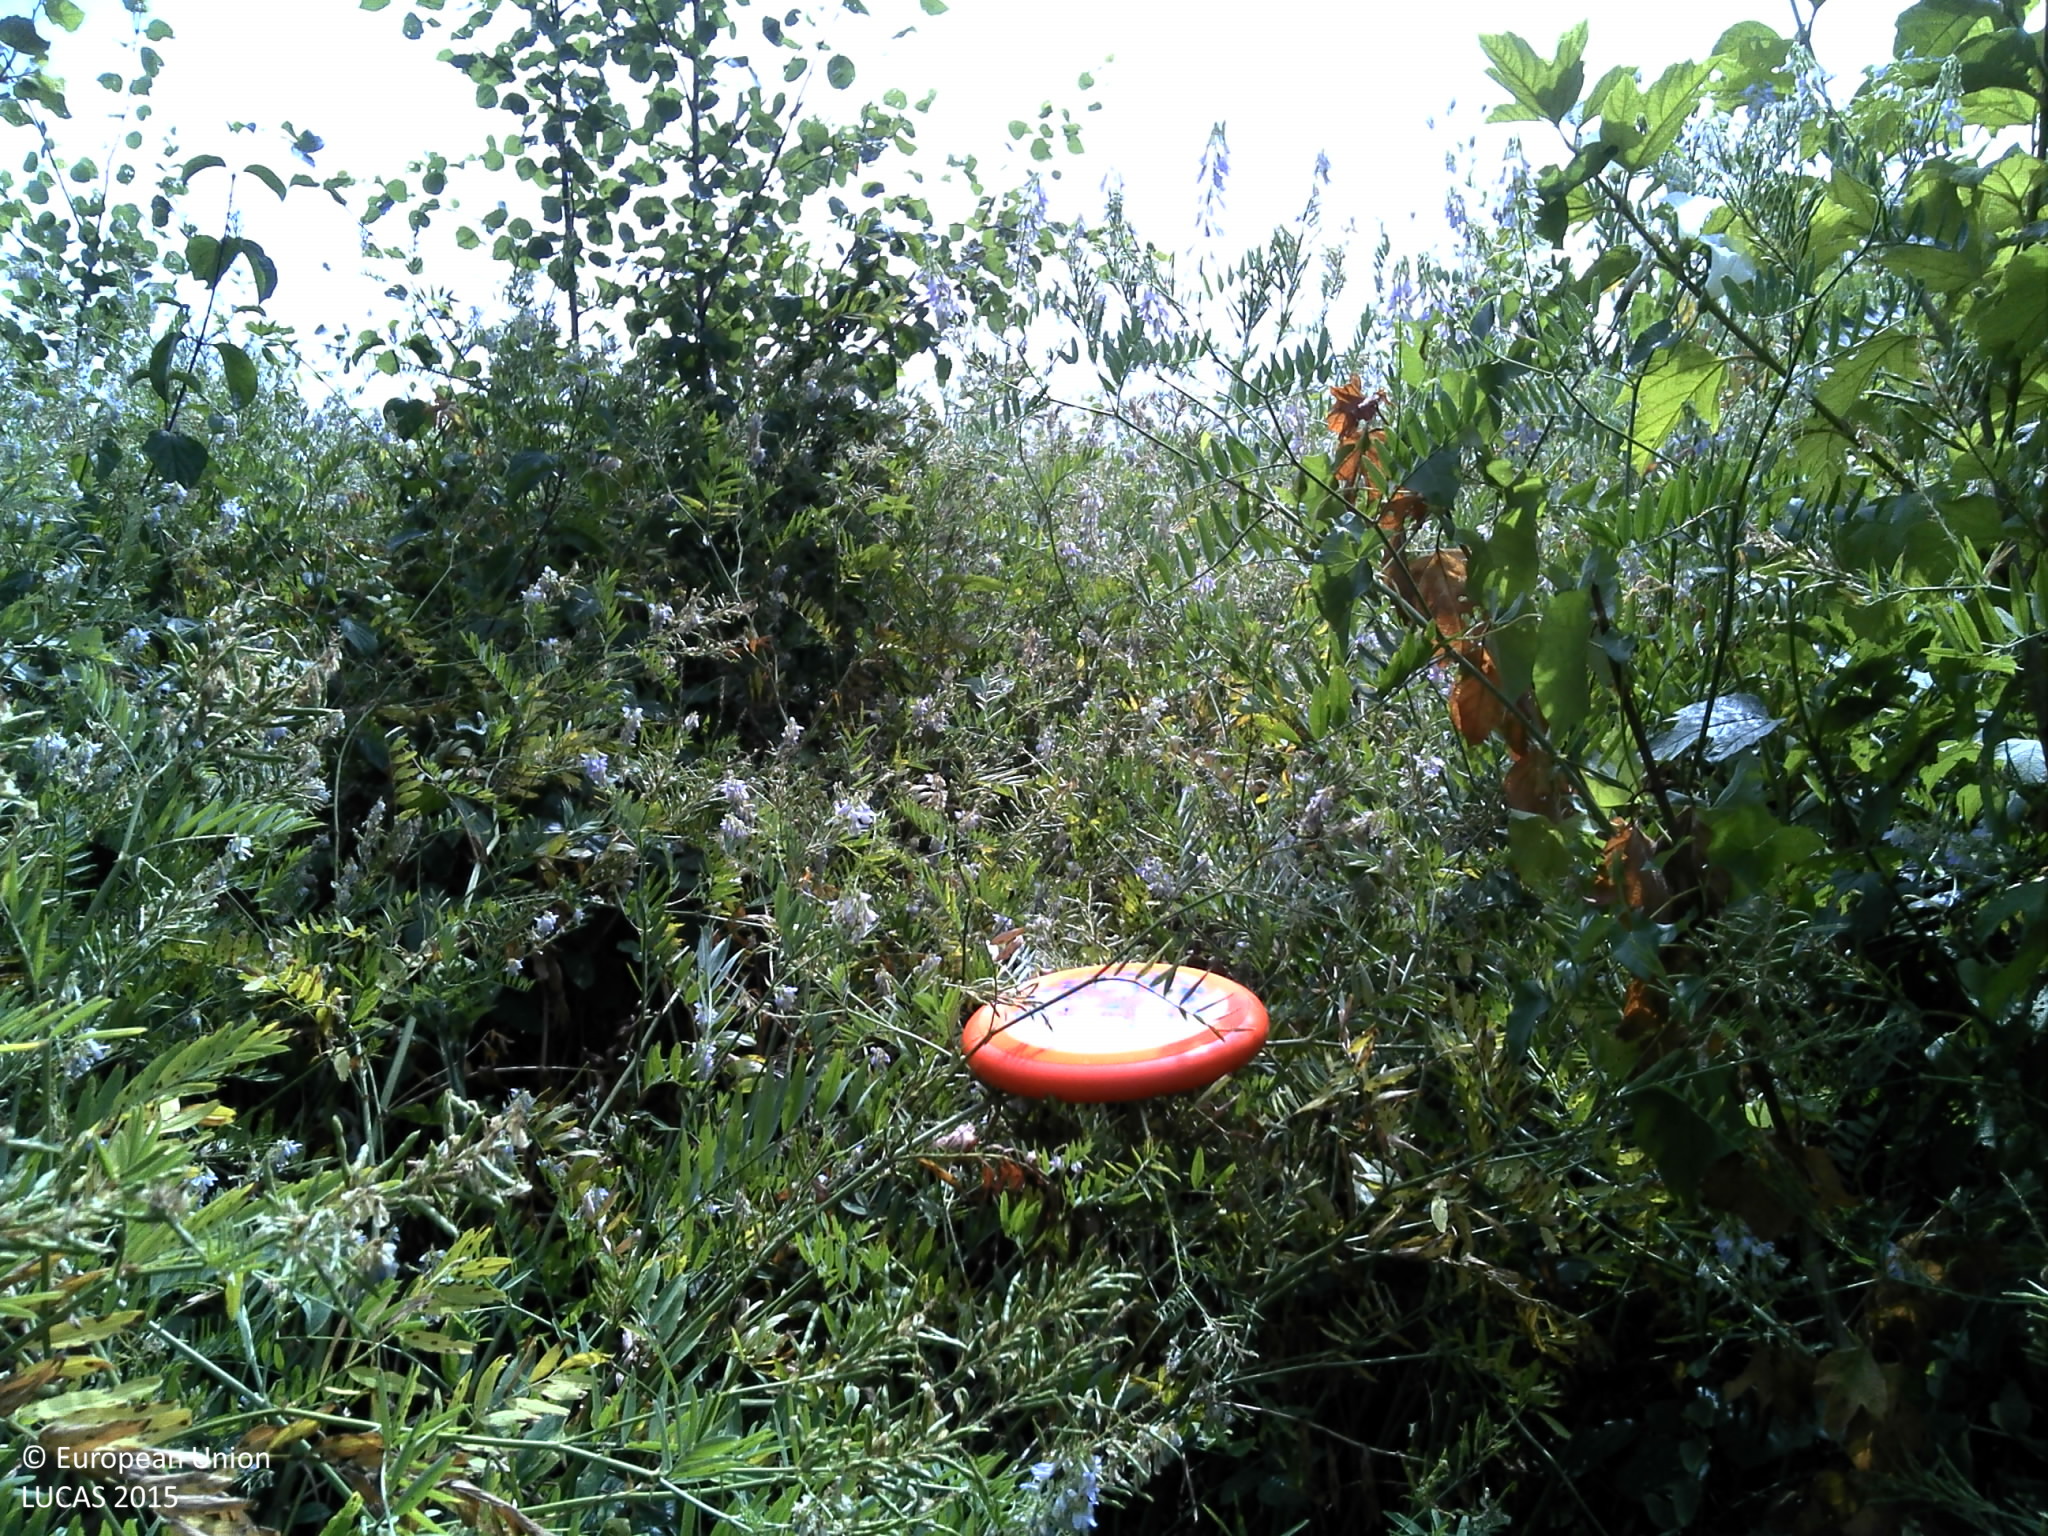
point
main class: Grassland
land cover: Spontaneously vegetated surfaces
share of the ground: > 75 %
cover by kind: herbaceous plants 95 %, shrubs 5 %
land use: Semi-natural and natural areas not in use
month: July
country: FR
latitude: 48.8992
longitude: 4.9096
